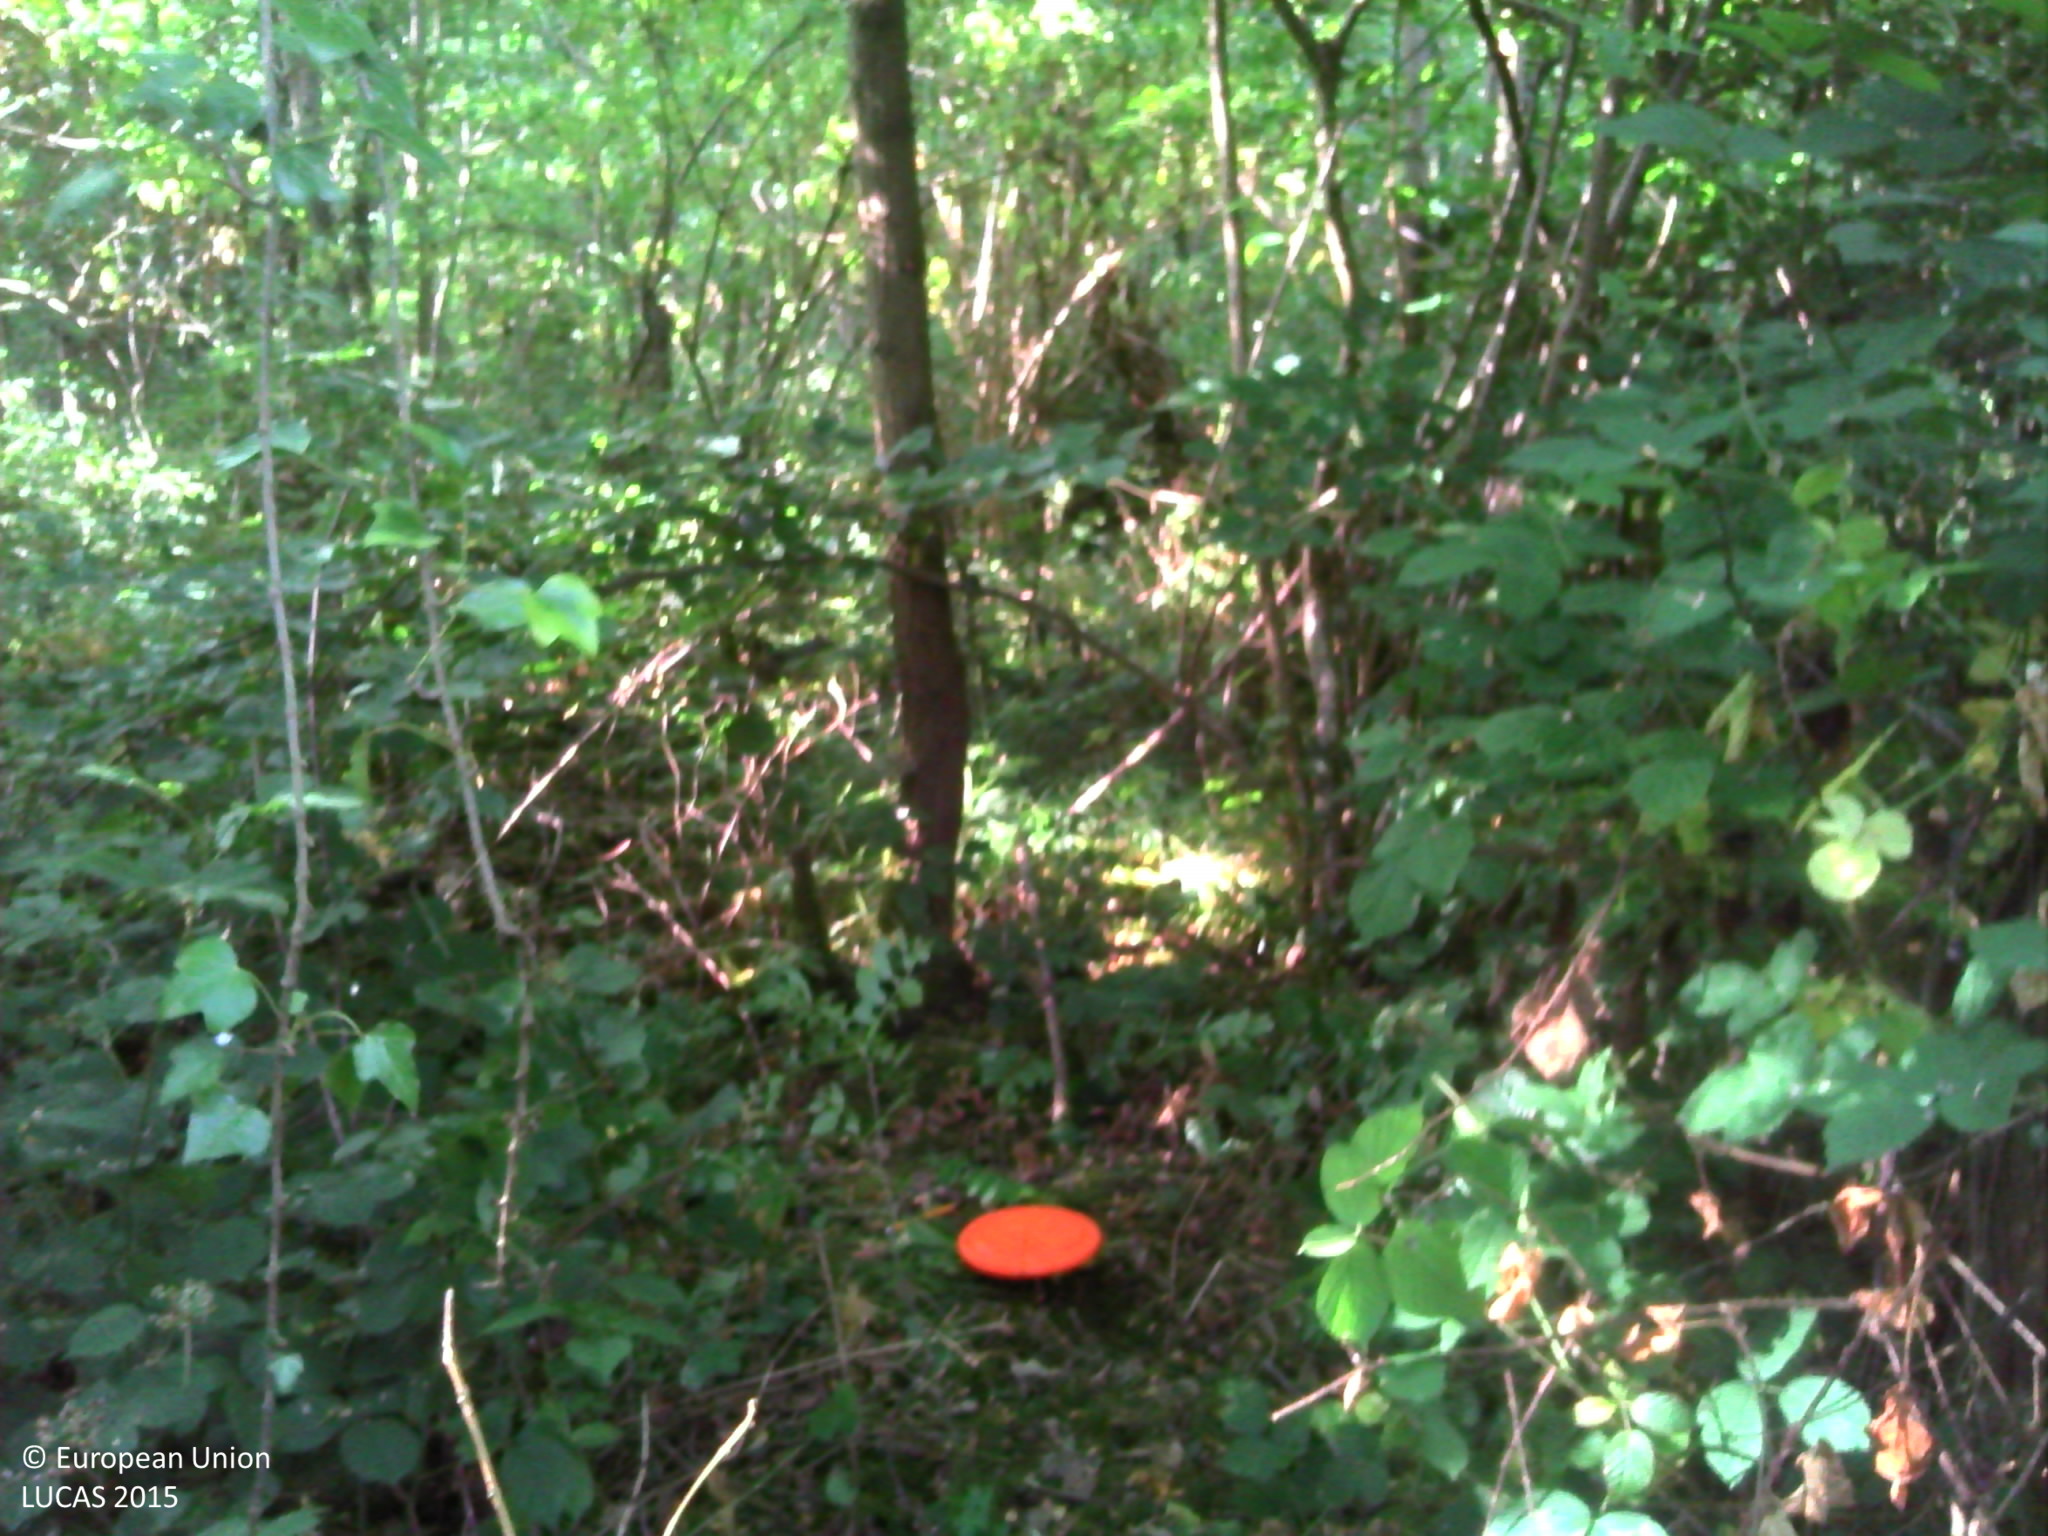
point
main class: Woodland
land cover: Broadleaved woodland
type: mesophytic deciduous forest
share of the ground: > 75 %
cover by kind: broadleaved forest trees 80 %, herbaceous plants 15 %, lichens and mosses 5 %
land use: Forestry
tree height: > 5 m
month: July
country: FR
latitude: 48.2413
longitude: 3.3825
